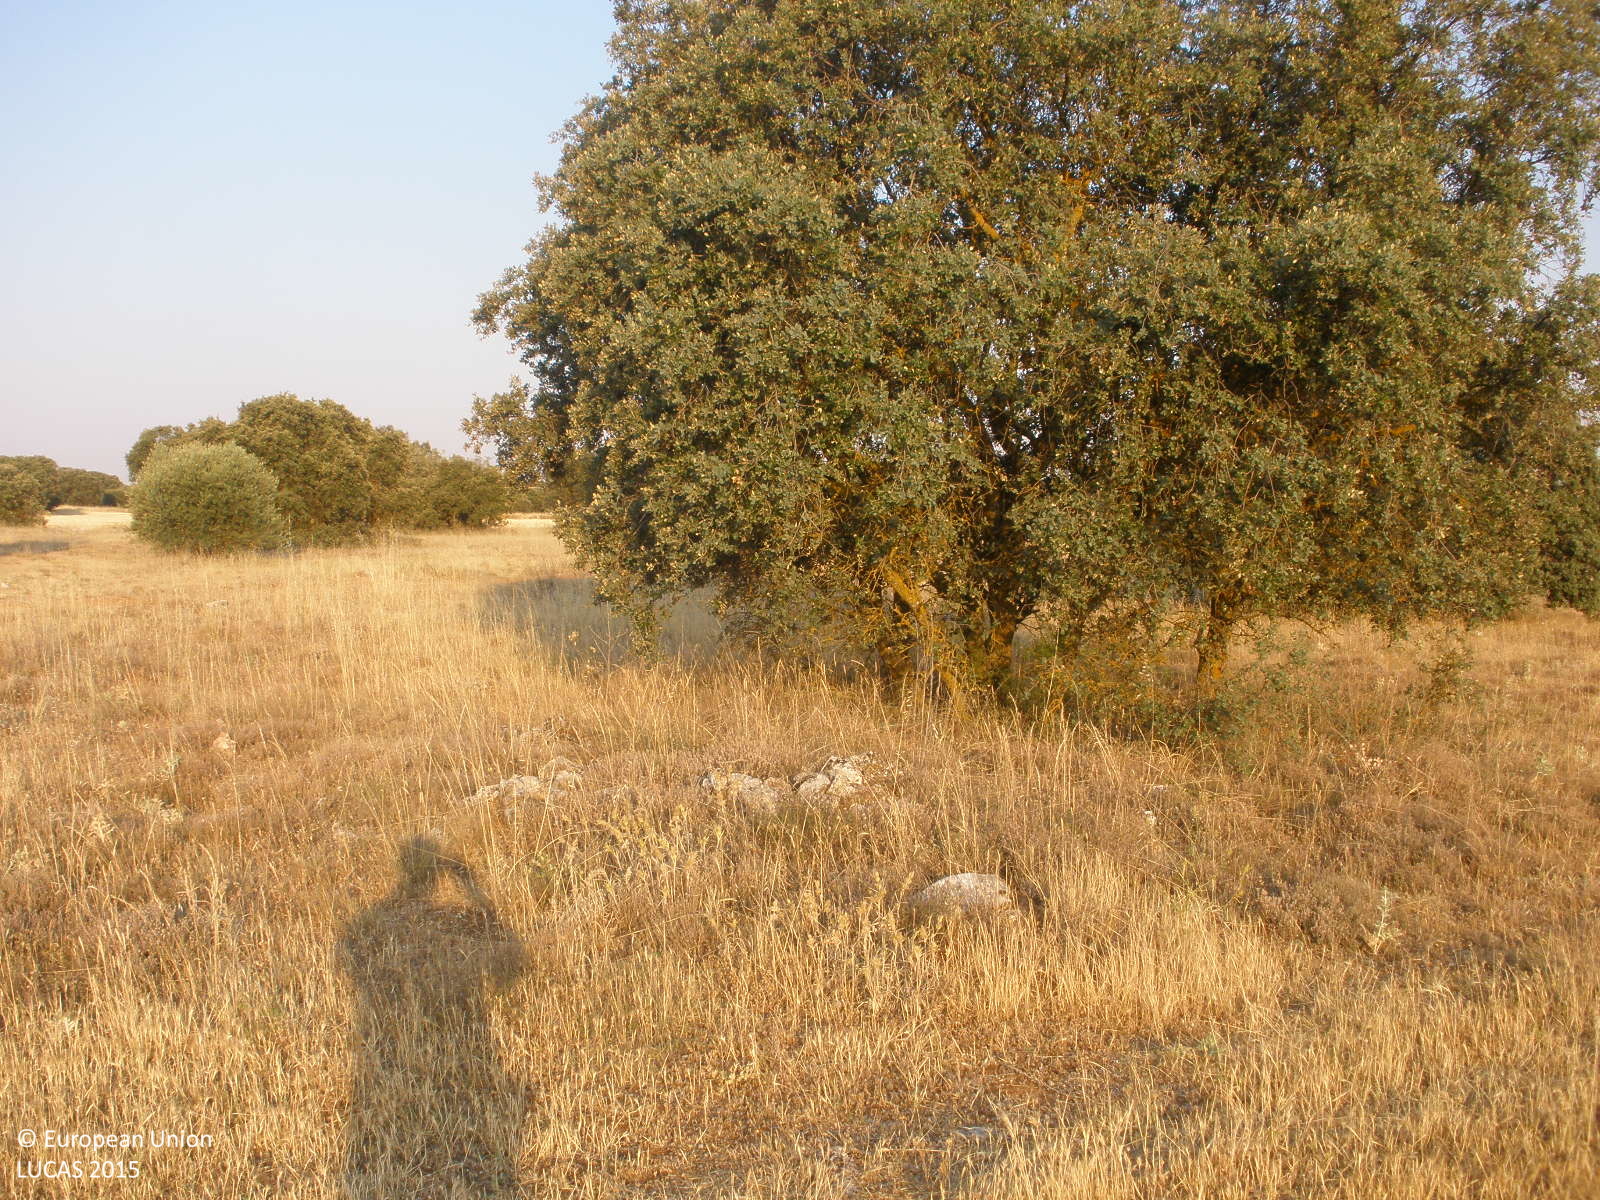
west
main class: Grassland
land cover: Grassland with sparse tree/shrub cover
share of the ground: > 75 %
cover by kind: herbaceous plants 90 %, broadleaved forest trees 5 %, shrubs 5 %
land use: Agriculture (excluding fallow land and kitchen gardens)
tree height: < 5 m
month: June
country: ES
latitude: 40.3282
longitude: -3.2958
